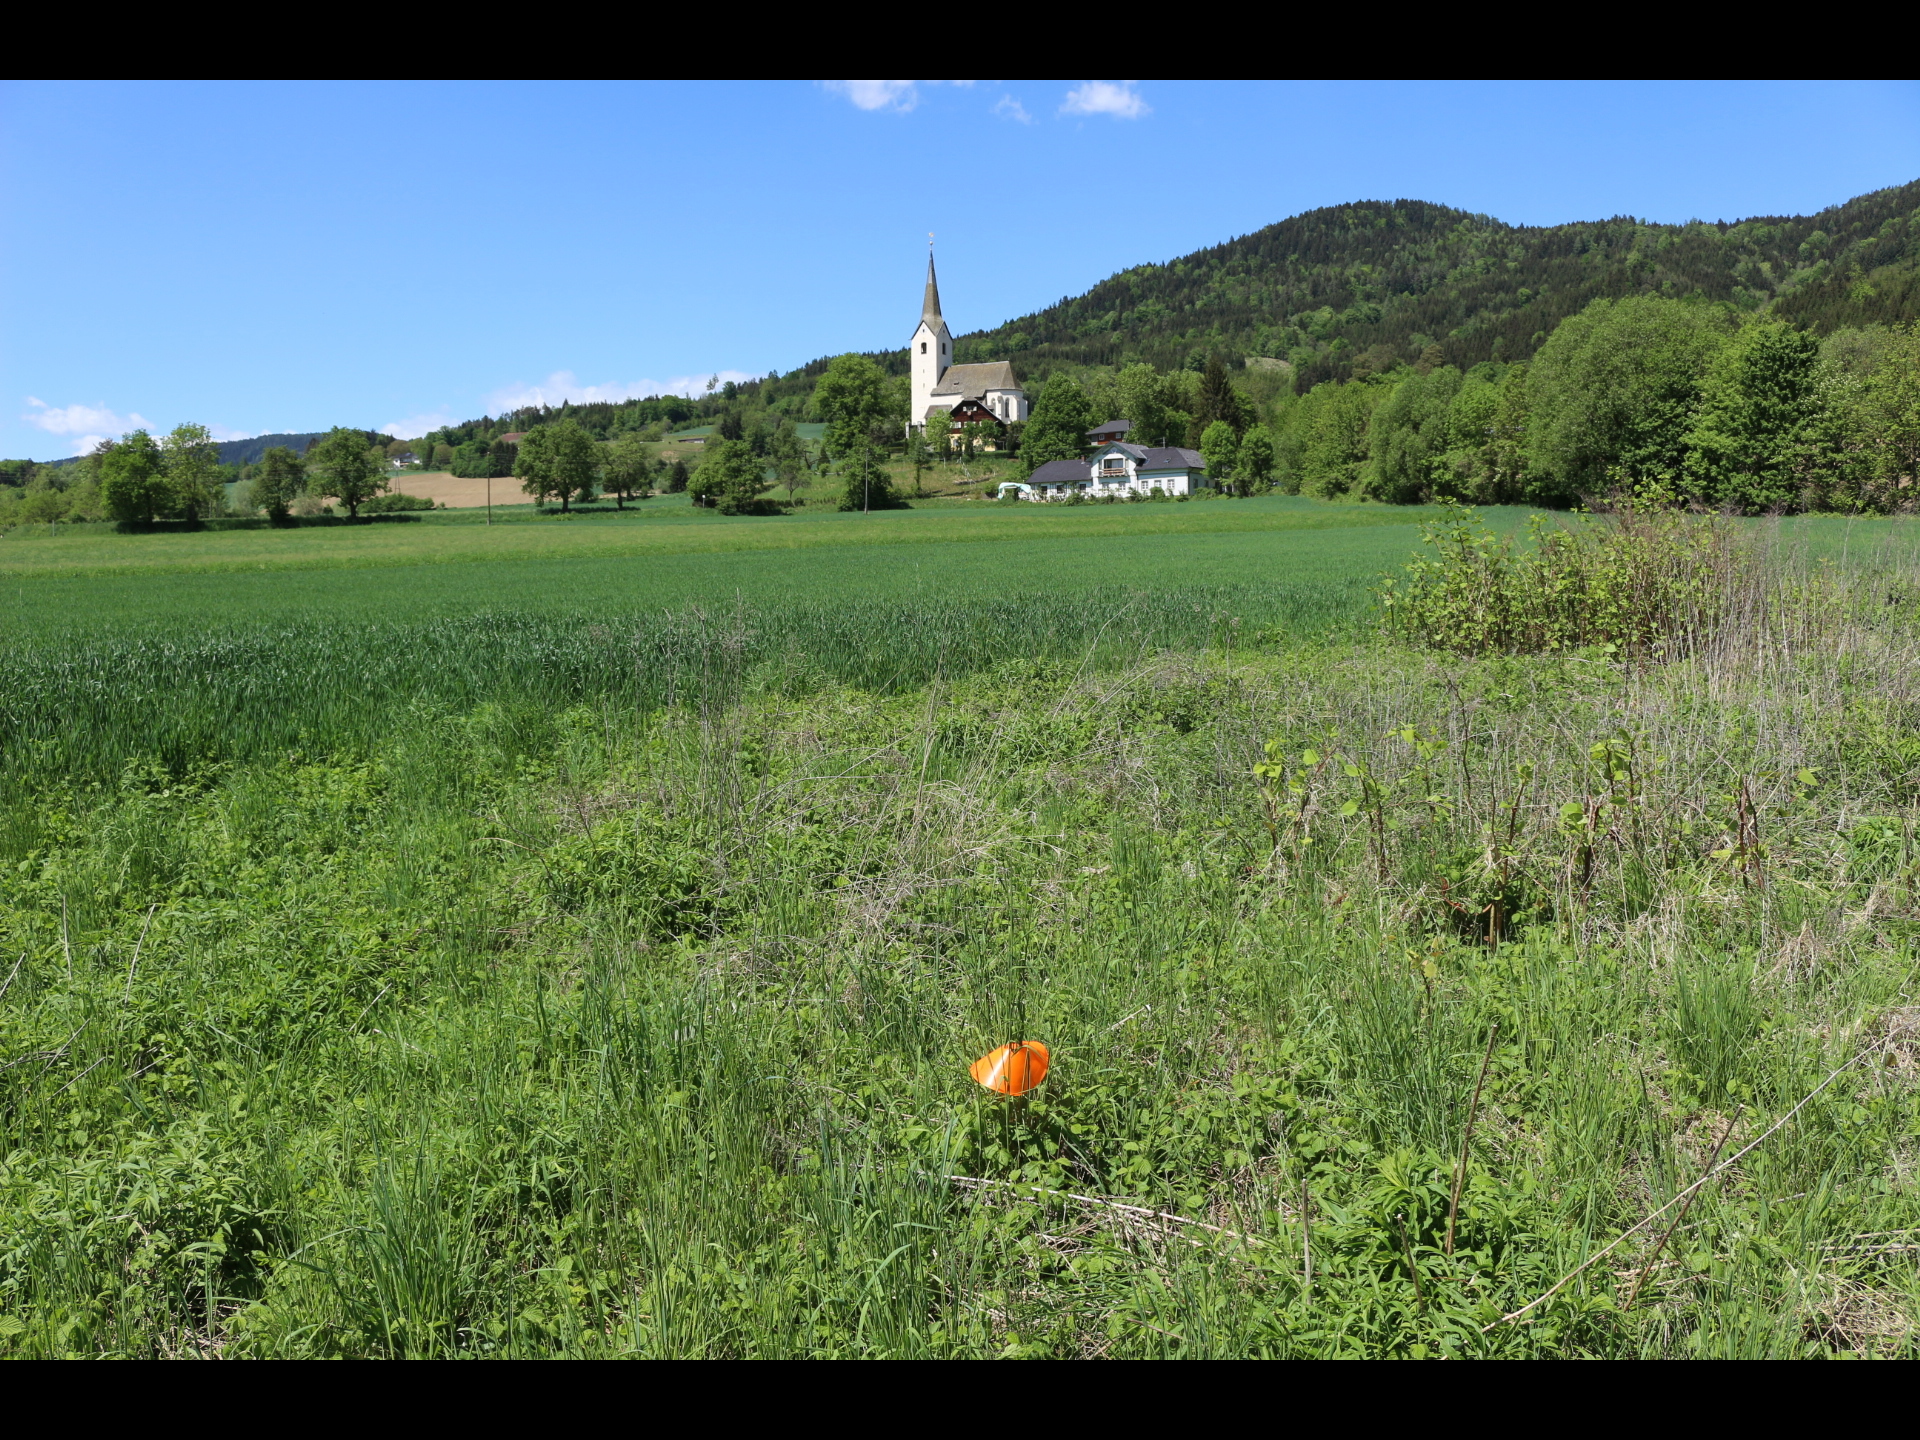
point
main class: Grassland
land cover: Spontaneously vegetated surfaces
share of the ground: > 75 %
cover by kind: herbaceous plants 95 %, shrubs 5 %
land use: Fallow land
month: May
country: AT
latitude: 46.6912
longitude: 14.4566
